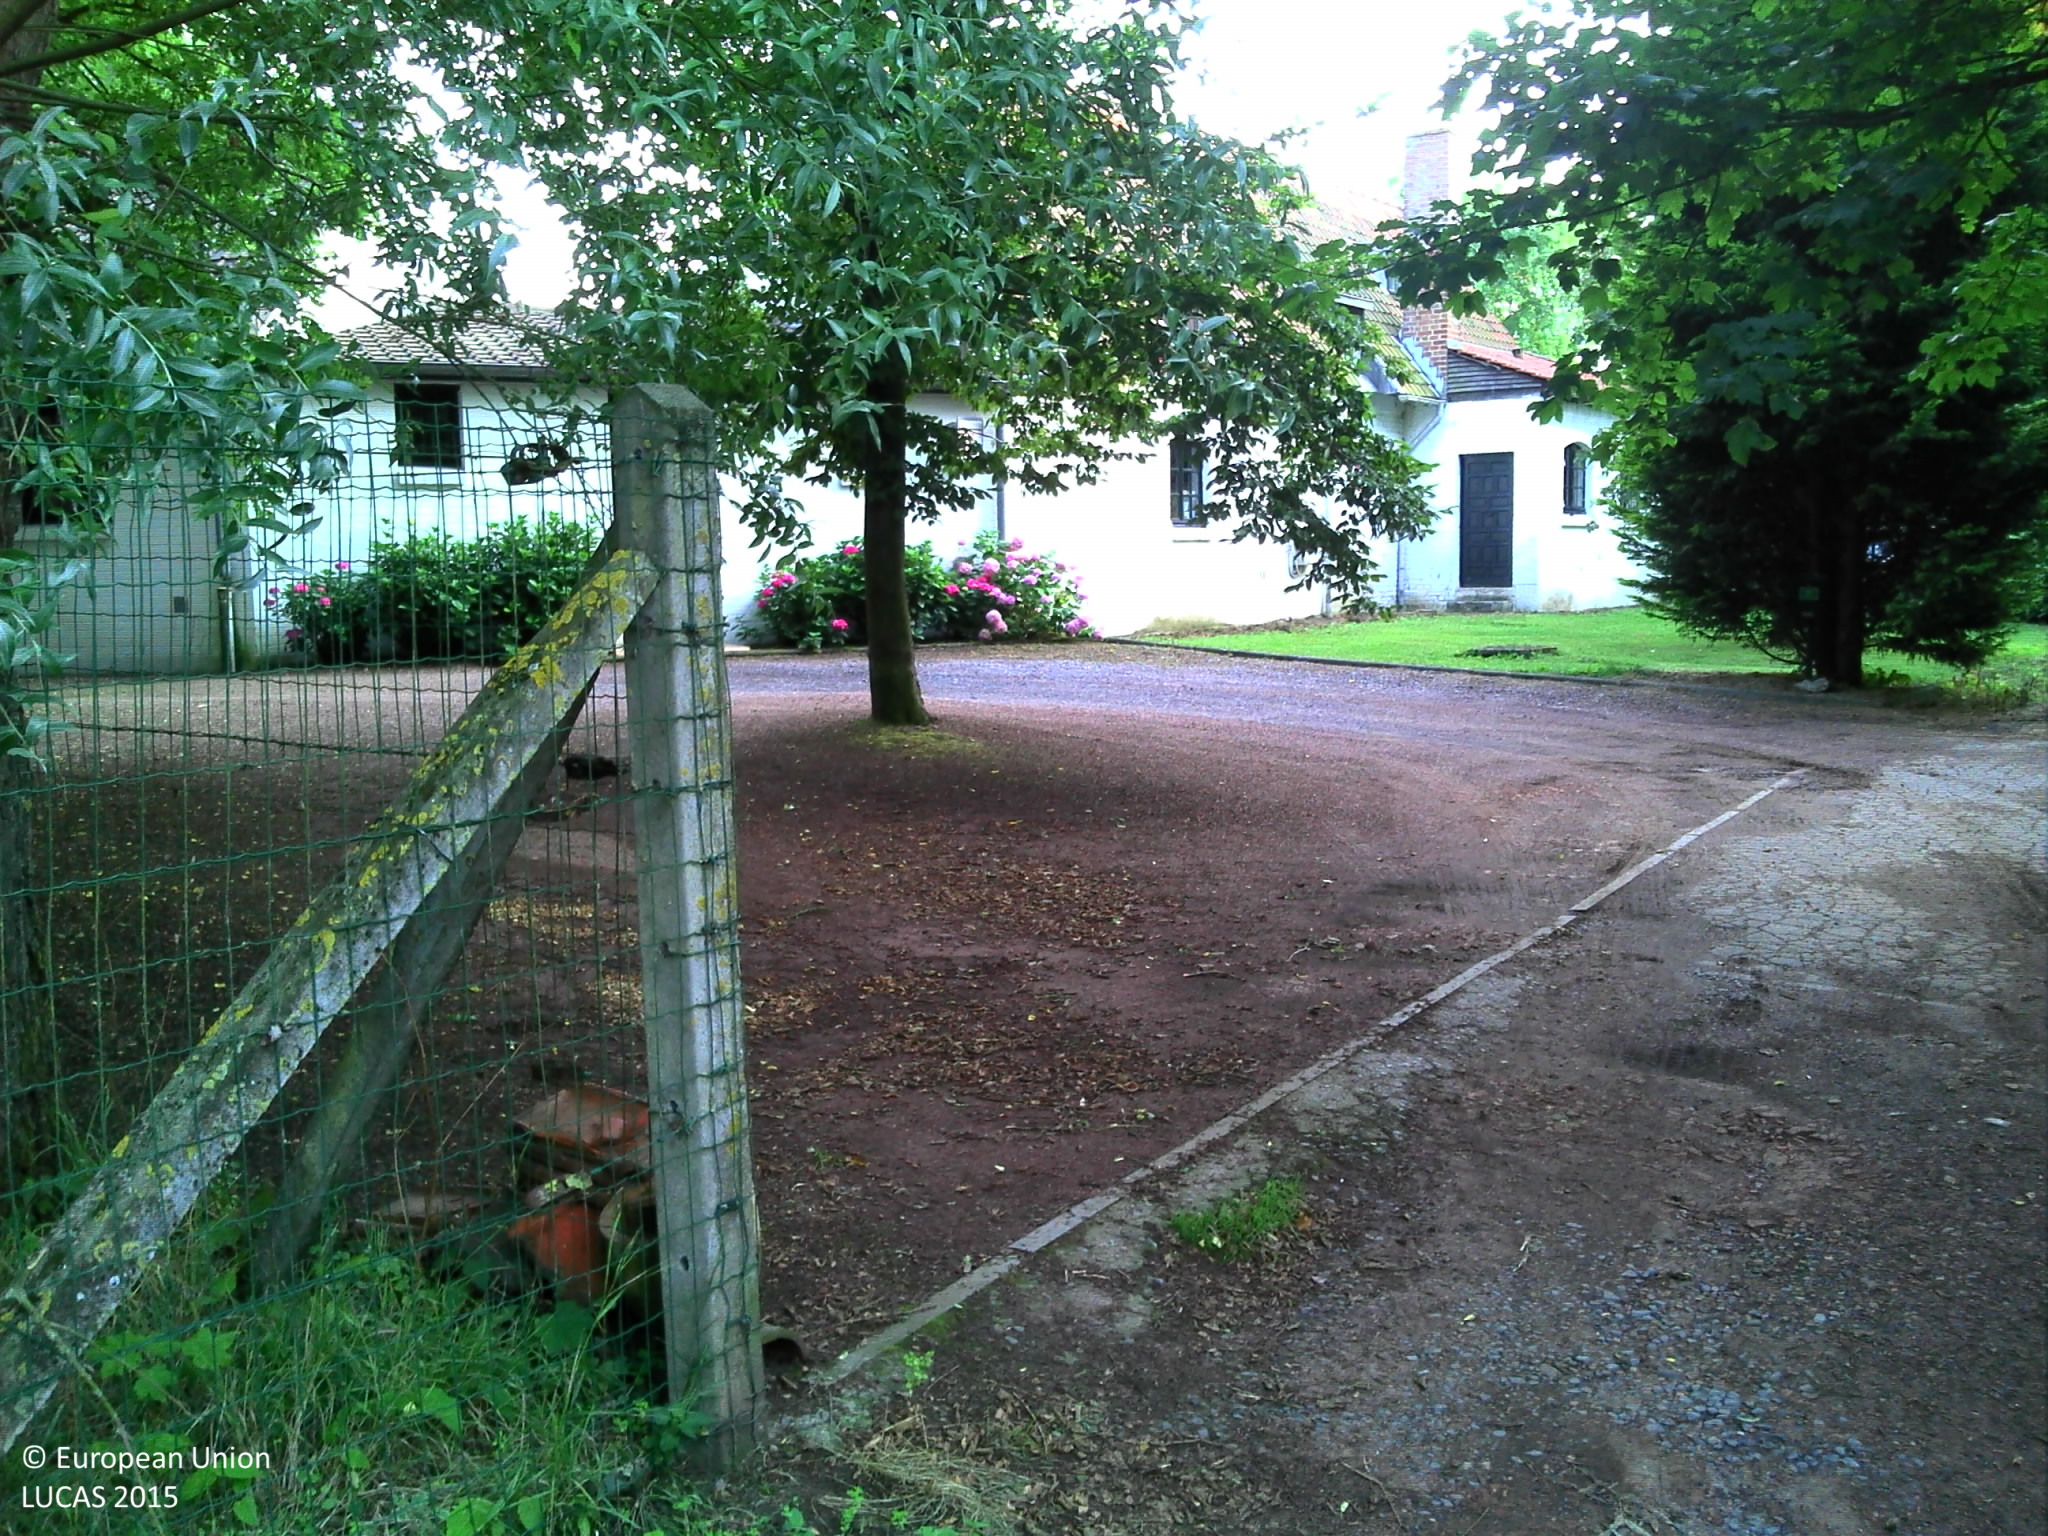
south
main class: Woodland
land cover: Broadleaved woodland
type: acidophilous oak and oak-birch forest
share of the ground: > 75 %
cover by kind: broadleaved forest trees 85 %, herbaceous plants 10 %, lichens and mosses 5 %
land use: Residential
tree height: > 5 m
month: July
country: FR
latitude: 50.7470
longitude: 3.0313
